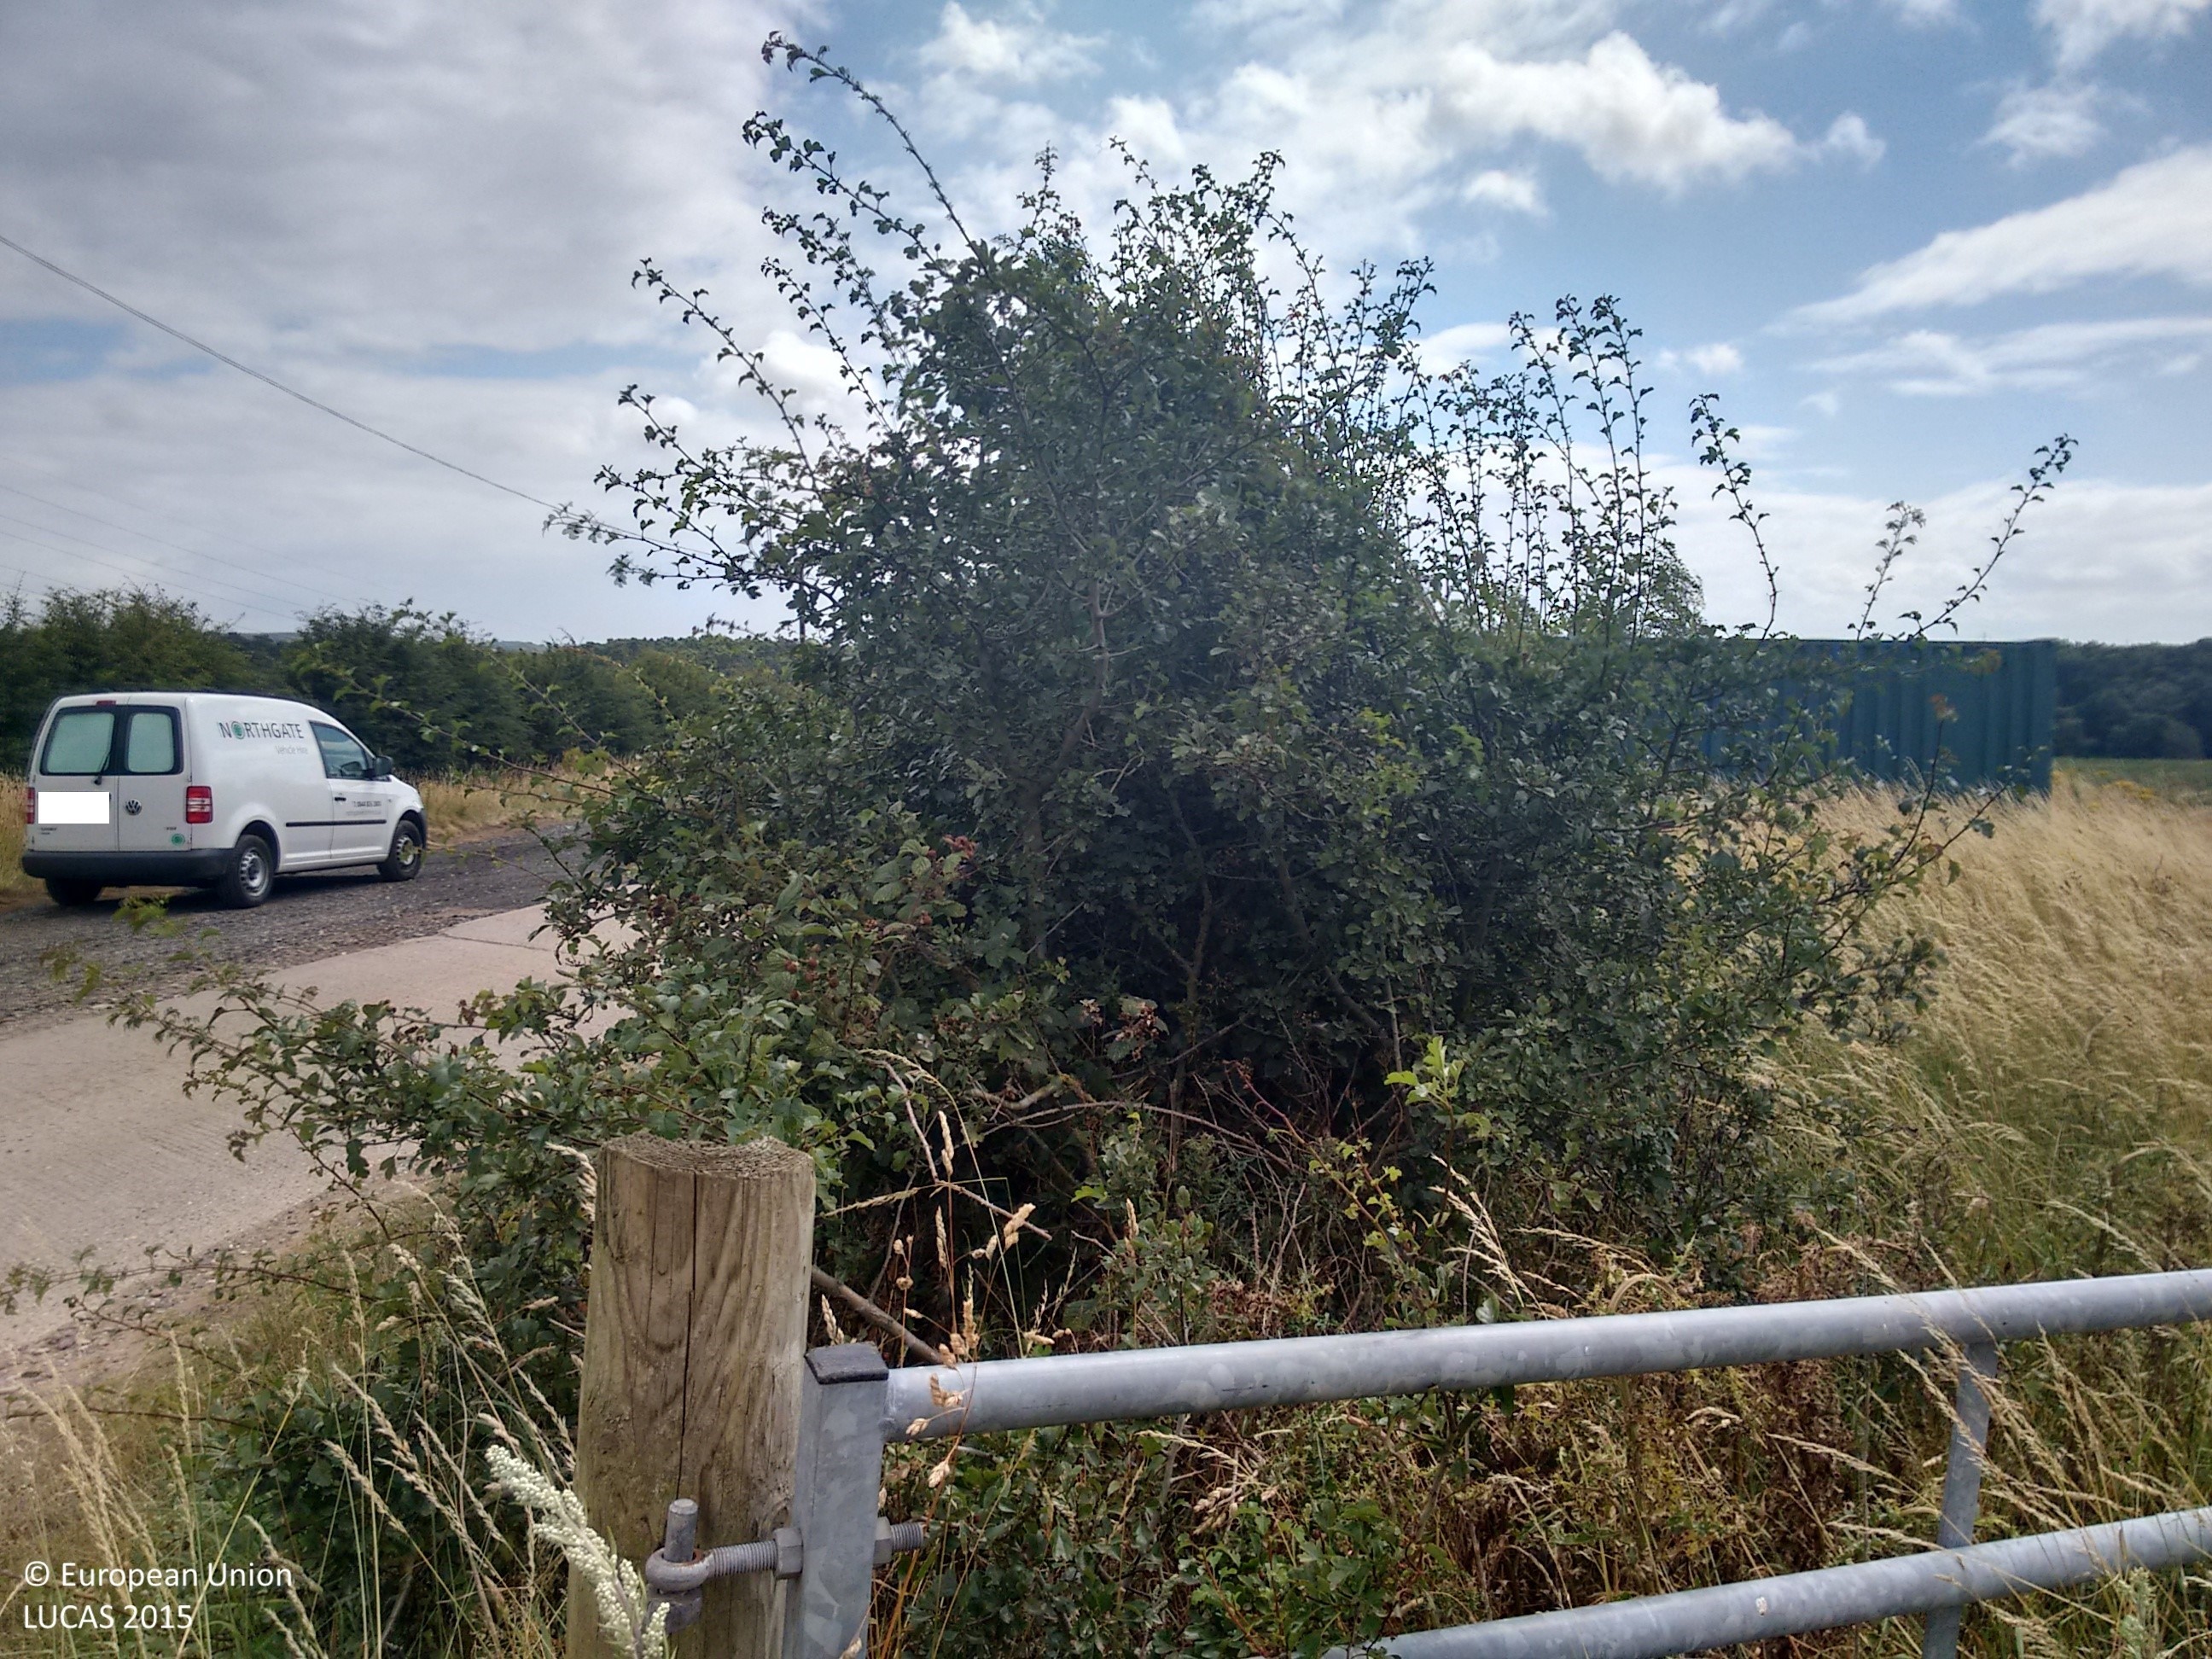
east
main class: Grassland
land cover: Spontaneously vegetated surfaces
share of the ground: > 75 %
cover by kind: herbaceous plants 100 %
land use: Agriculture (excluding fallow land and kitchen gardens)
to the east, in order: Spontaneously vegetated surfaces
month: July
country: GB
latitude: 53.1296
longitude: -1.0593
